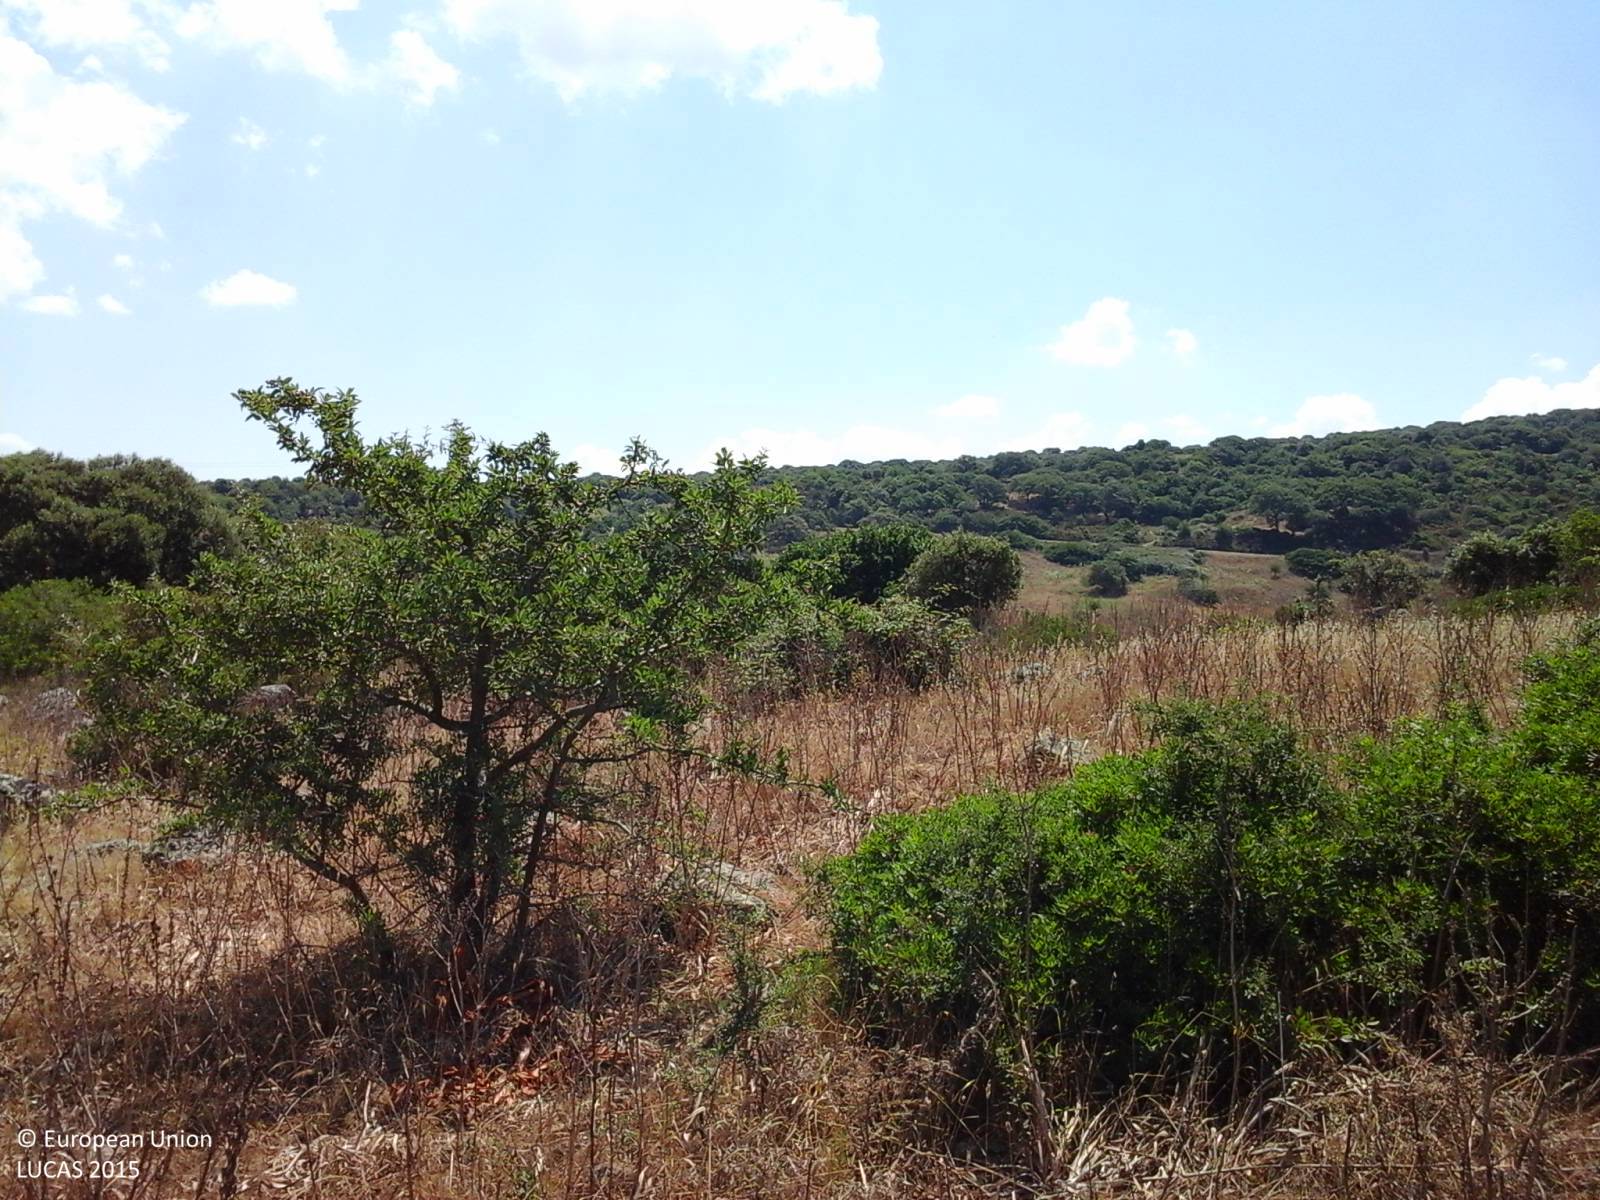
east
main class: Grassland
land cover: Grassland without tree/shrub cover
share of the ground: > 75 %
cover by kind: herbaceous plants 95 %, shrubs 5 %
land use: Agriculture (excluding fallow land and kitchen gardens)
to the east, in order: Grassland without tree/shrub cover; Shrubland with sparse tree cover; Broadleaved woodland; Rivers and streams; Broadleaved woodland
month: June
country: IT
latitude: 40.7494
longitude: 8.8567
